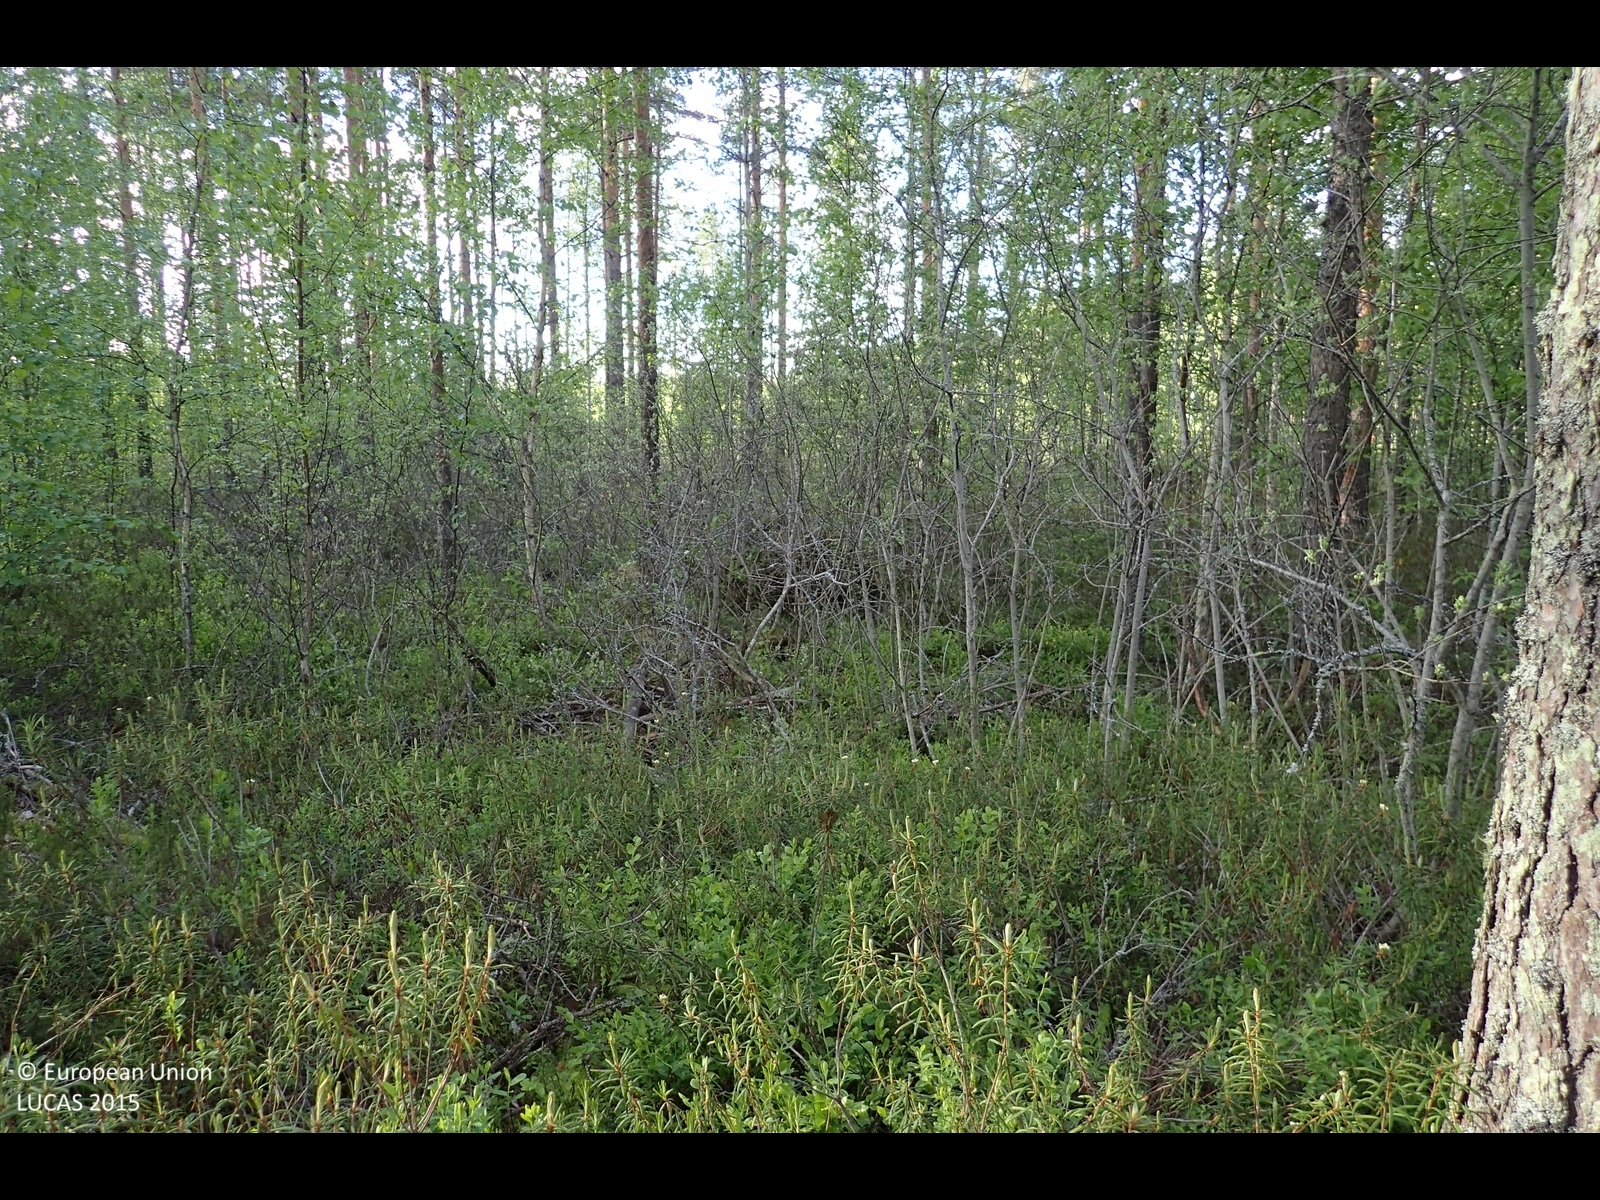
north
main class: Woodland
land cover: Pine dominated coniferous woodland
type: boreal forest
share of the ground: 25 - 50 %
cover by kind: shrubs 55 %, coniferous forest trees 40 %, broadleaved forest trees 5 %
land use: Forestry
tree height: > 5 m
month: June
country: FI
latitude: 62.4398
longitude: 23.1035
